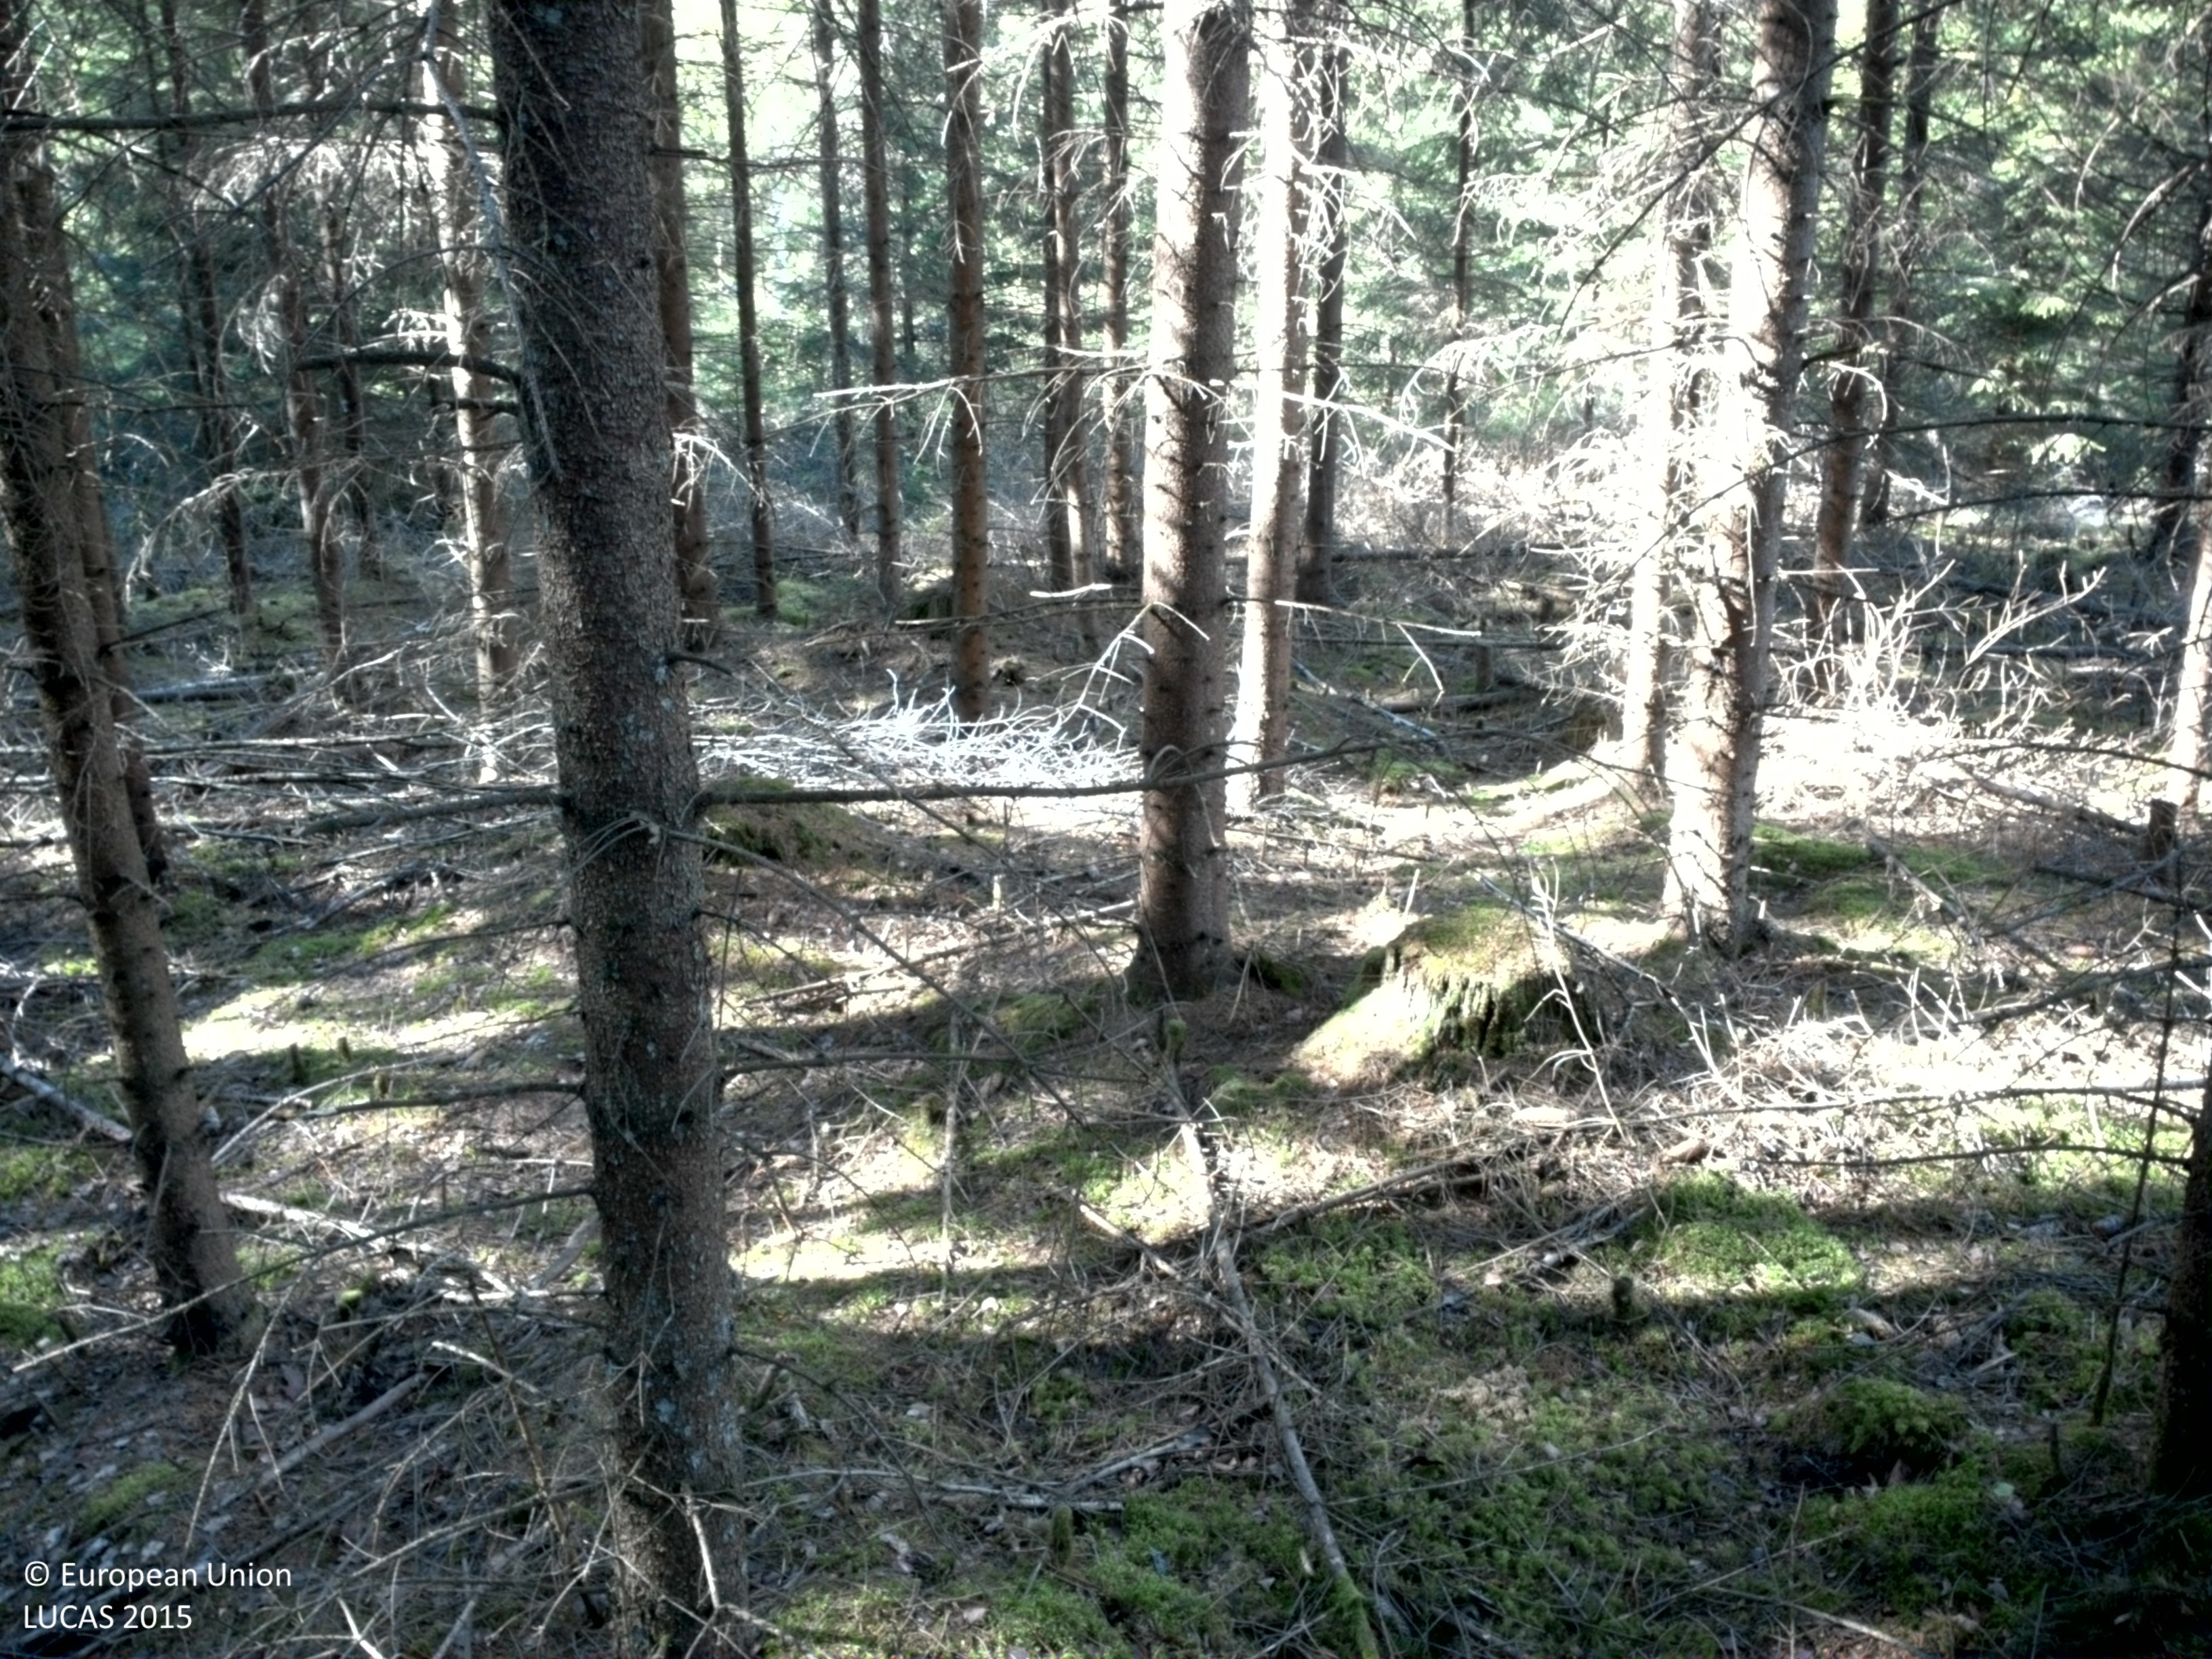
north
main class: Woodland
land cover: Spruce dominated coniferous woodland
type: boreal forest
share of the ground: > 75 %
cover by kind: coniferous forest trees 80 %, lichens and mosses 15 %, broadleaved forest trees 5 %
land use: Forestry
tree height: > 5 m
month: May
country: SE
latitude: 56.5667
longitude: 15.2549
